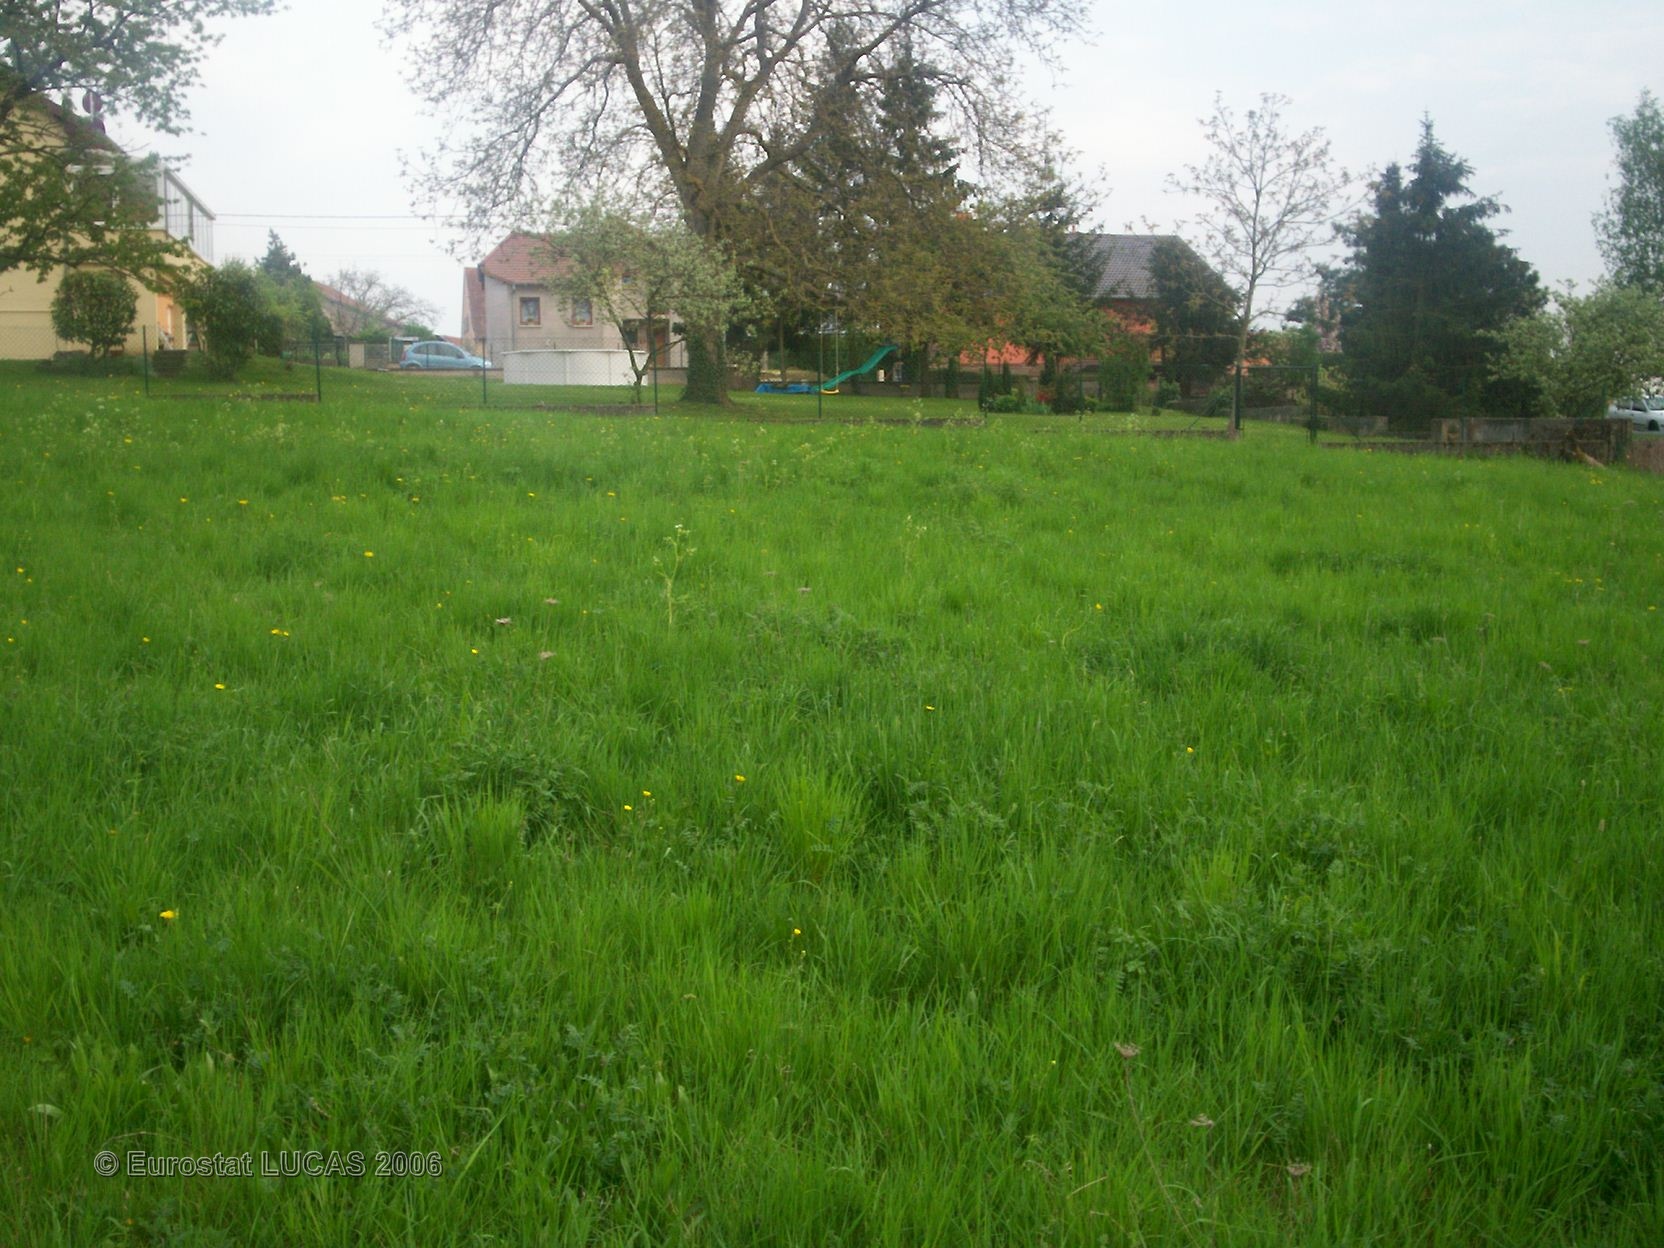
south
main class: Grassland
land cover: Grassland with sparse tree/shrub cover
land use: Agriculture (excluding fallow land and kitchen gardens)
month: May
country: FR
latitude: 48.7775
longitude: 7.0204
